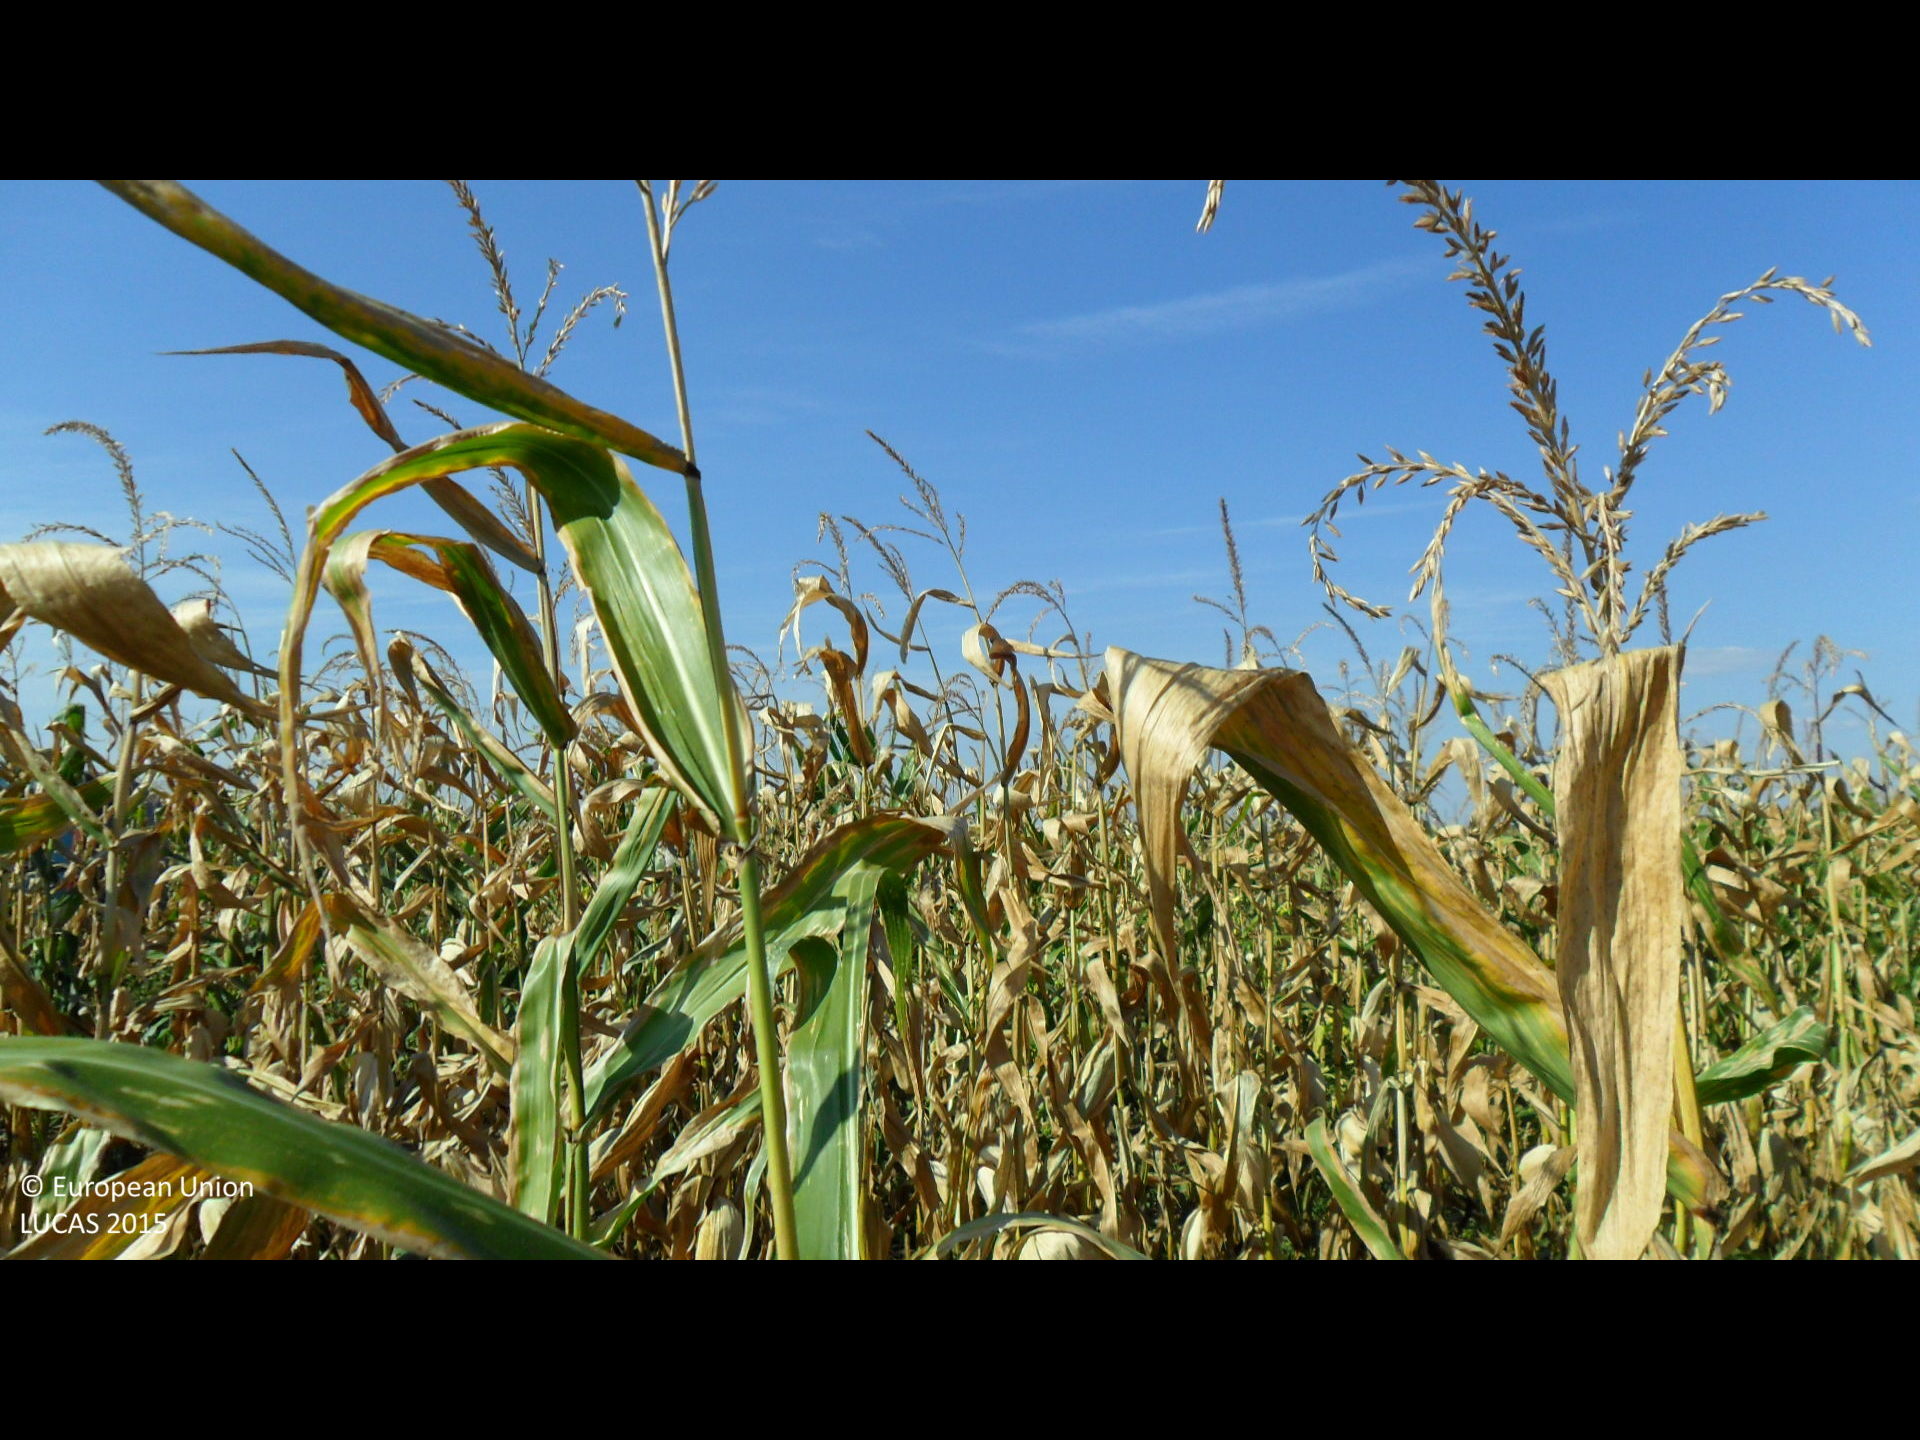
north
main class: Cropland
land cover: Maize
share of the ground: > 75 %
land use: Agriculture (excluding fallow land and kitchen gardens)
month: August
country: BG
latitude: 43.4865
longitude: 26.3353
